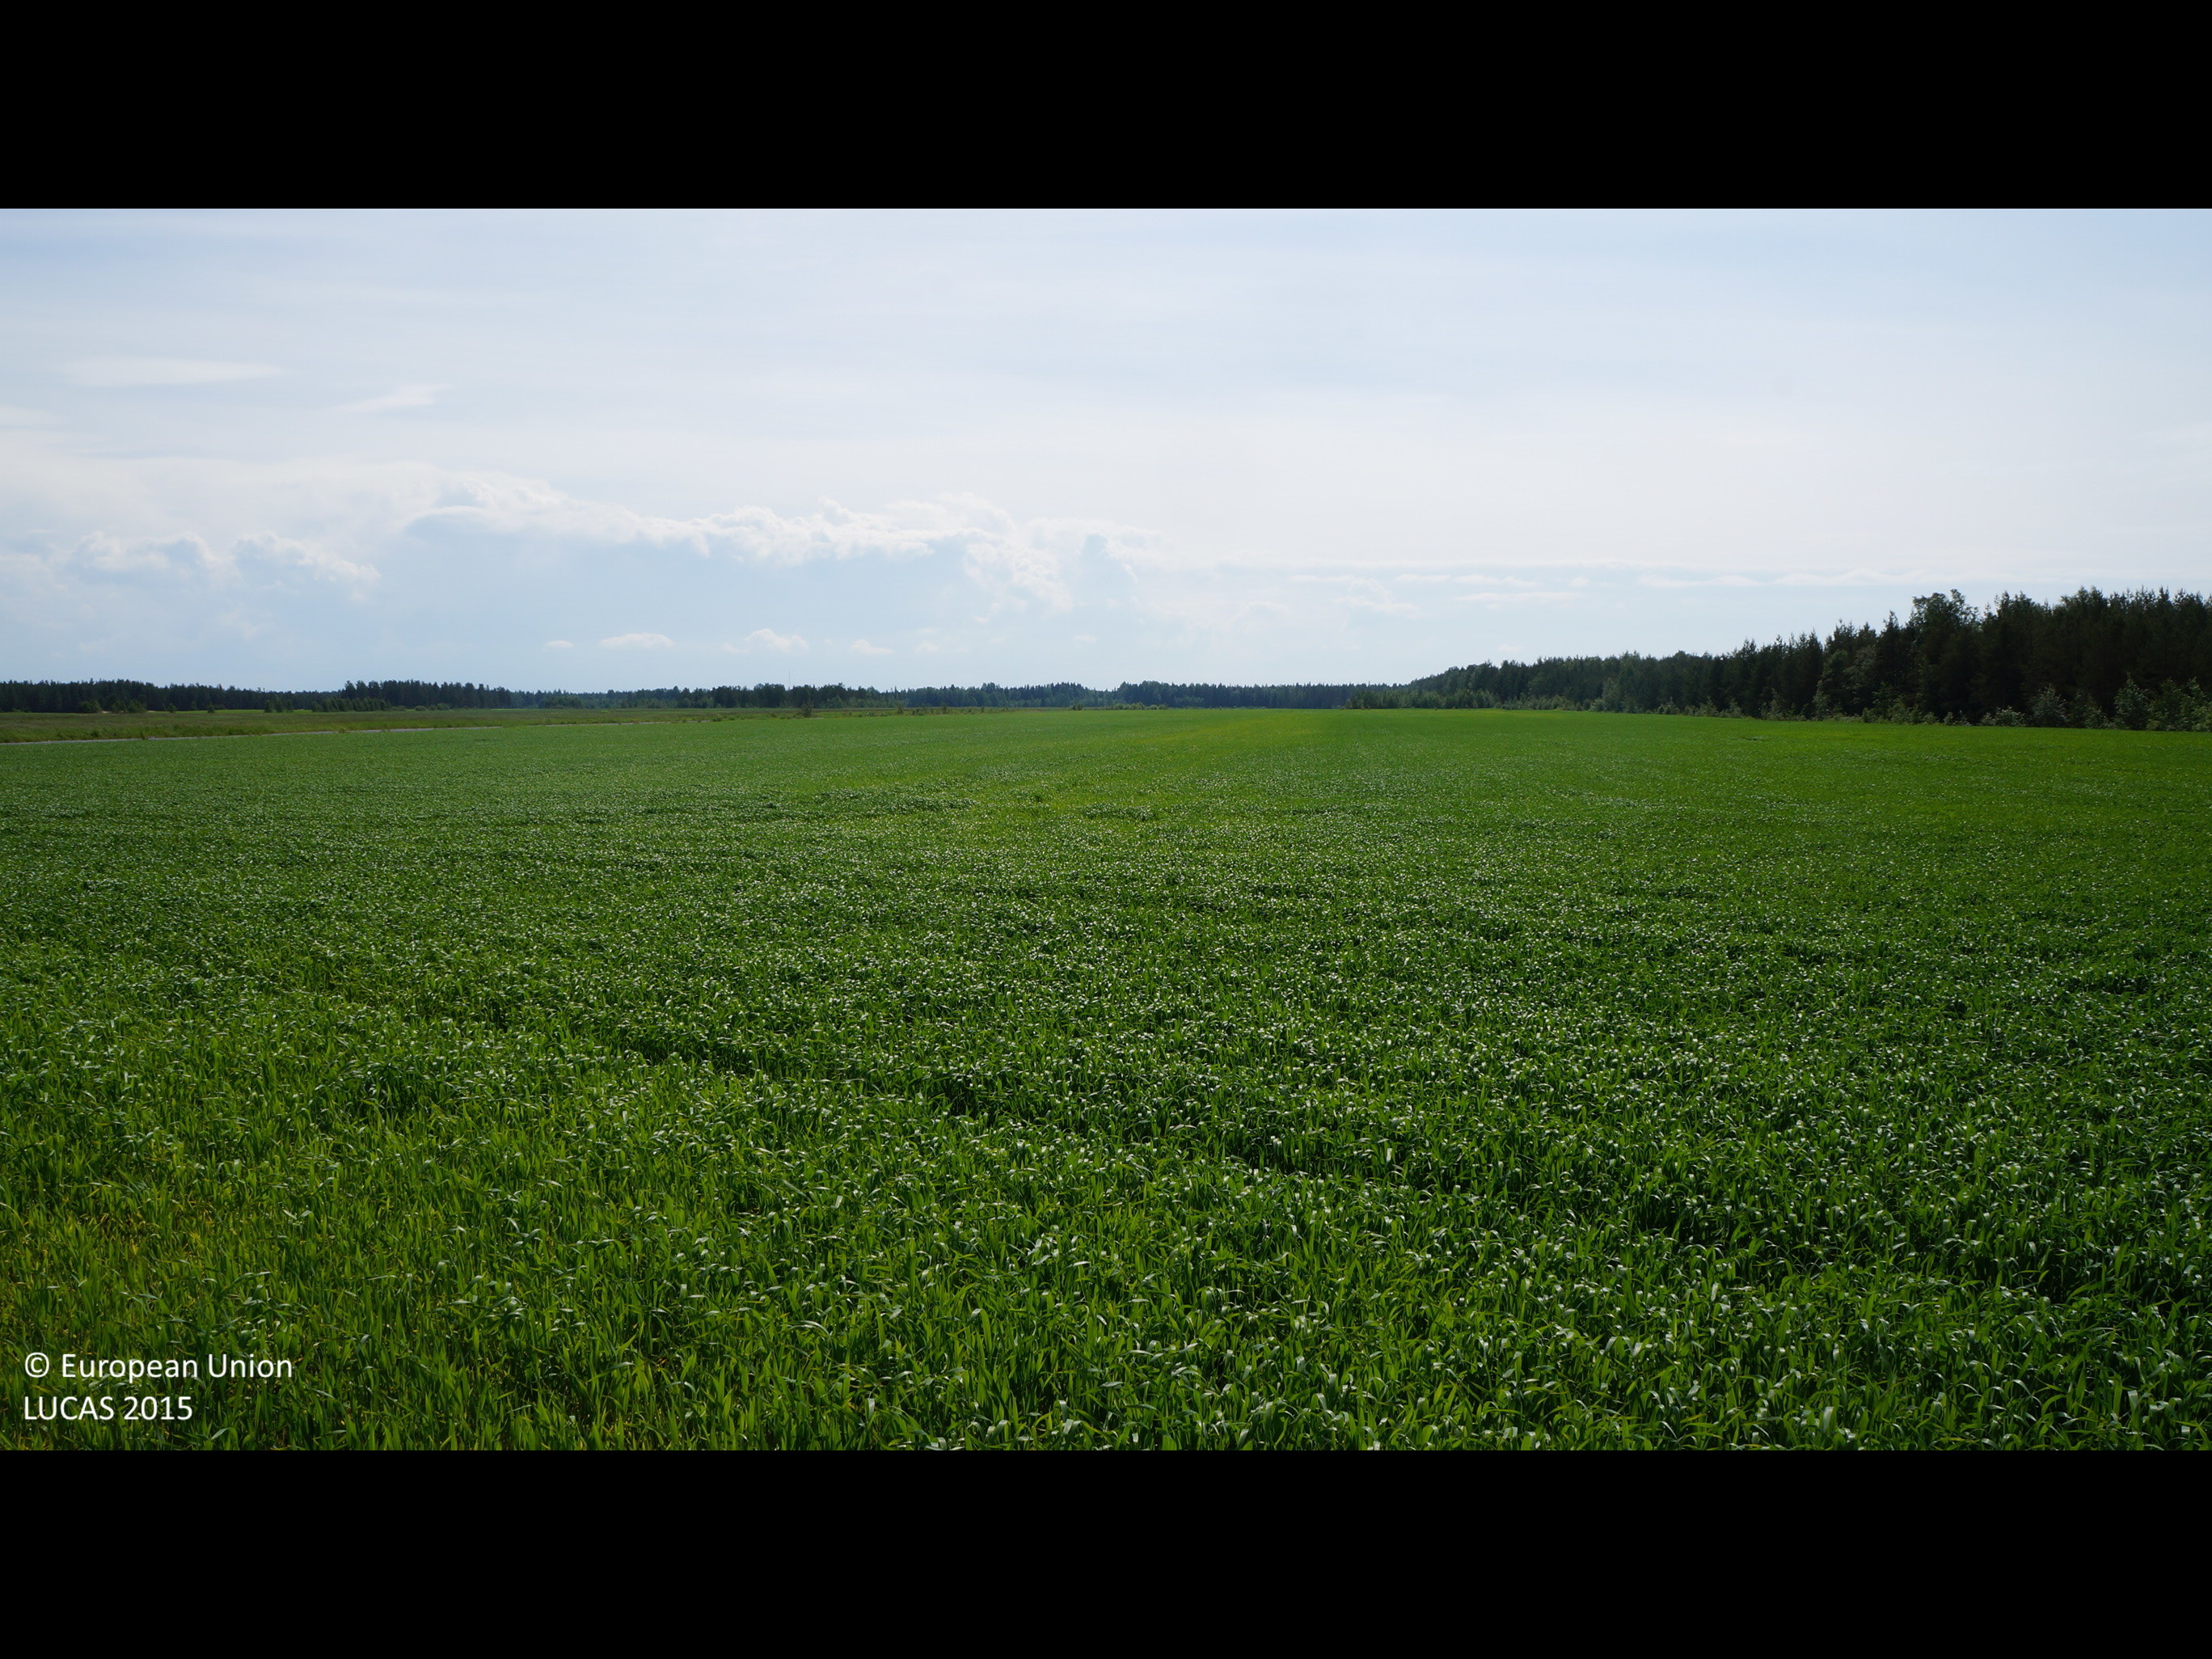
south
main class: Cropland
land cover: Common wheat
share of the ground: > 75 %
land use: Agriculture (excluding fallow land and kitchen gardens)
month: June
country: FI
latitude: 64.1508
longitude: 23.8967
